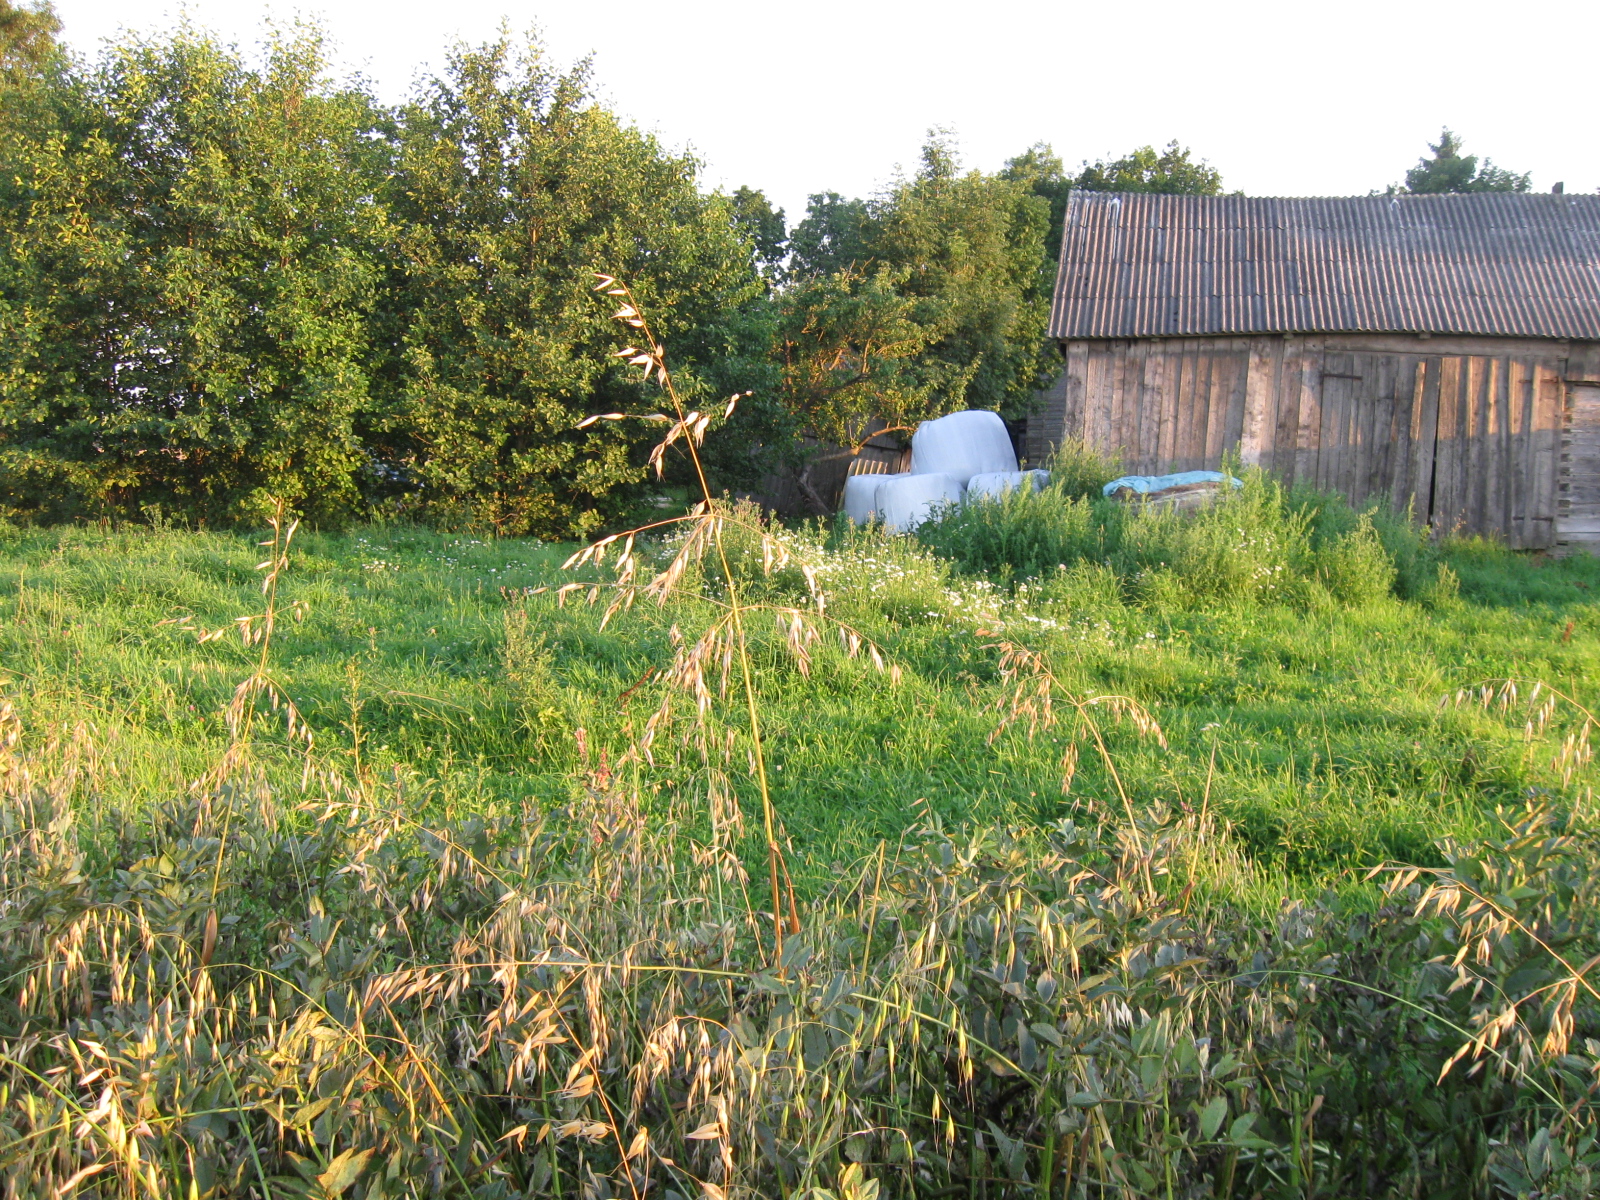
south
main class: Cropland
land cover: Dry pulses
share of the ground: > 75 %
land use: Agriculture (excluding fallow land and kitchen gardens)
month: August
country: LT
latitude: 55.0132
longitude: 23.1633
